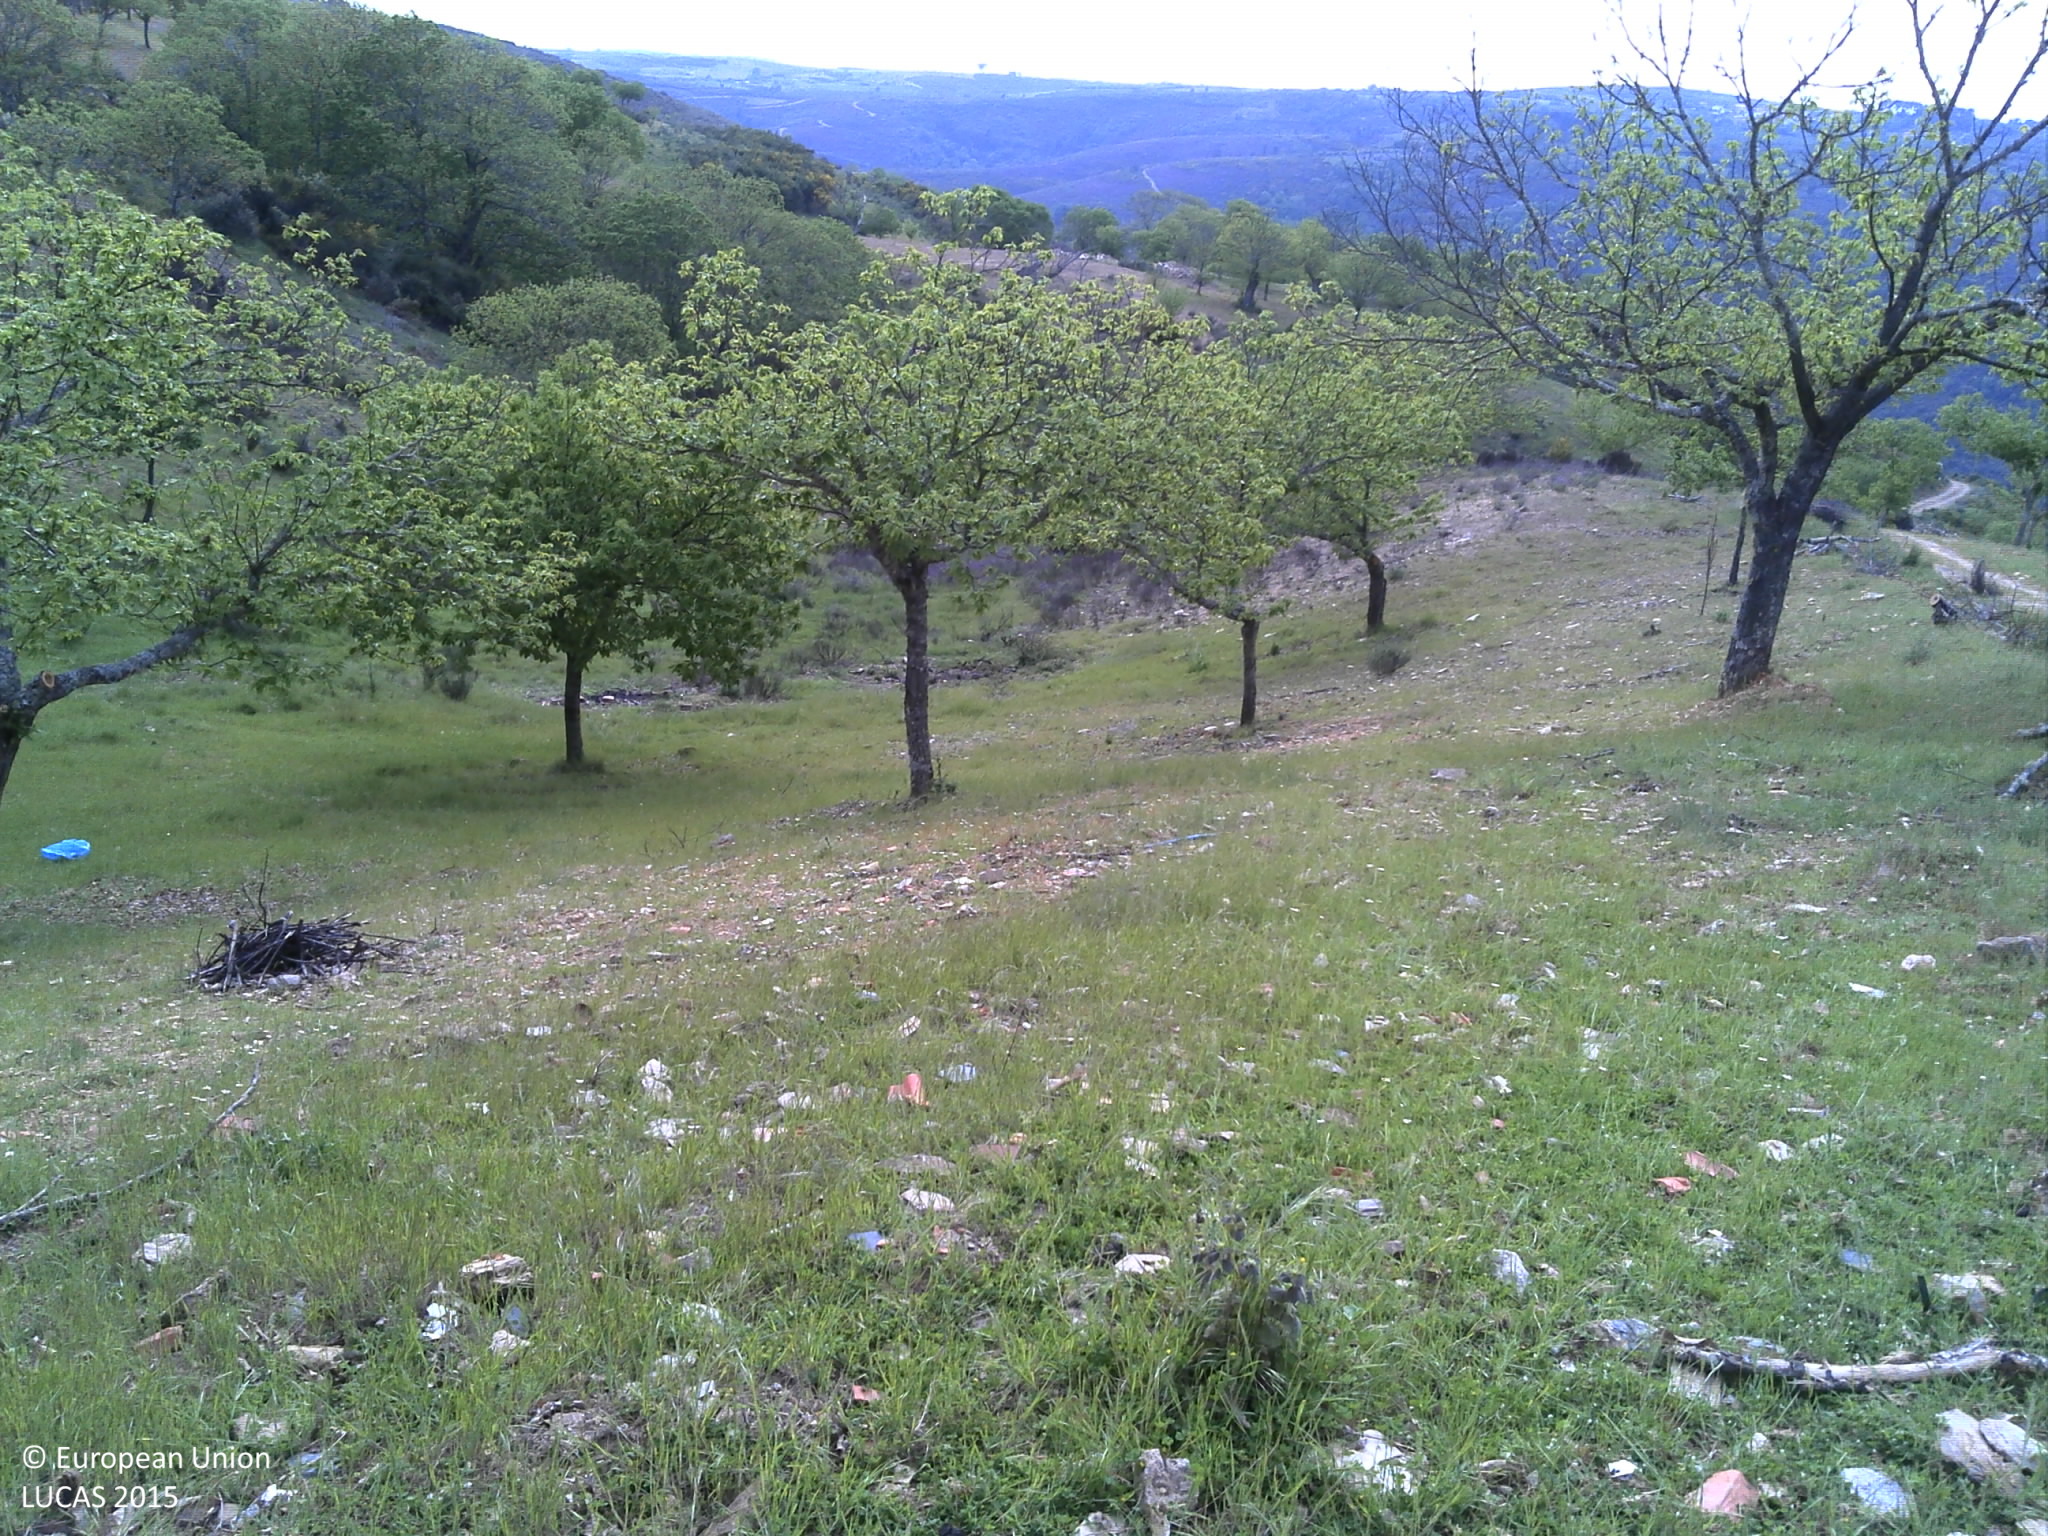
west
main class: Cropland
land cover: Nuts trees
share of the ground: 10 - 25 %
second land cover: Grassland without tree/shrub cover
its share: 25 - 50 %
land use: Agriculture (excluding fallow land and kitchen gardens)
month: May
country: PT
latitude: 41.9040
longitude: -7.1083
